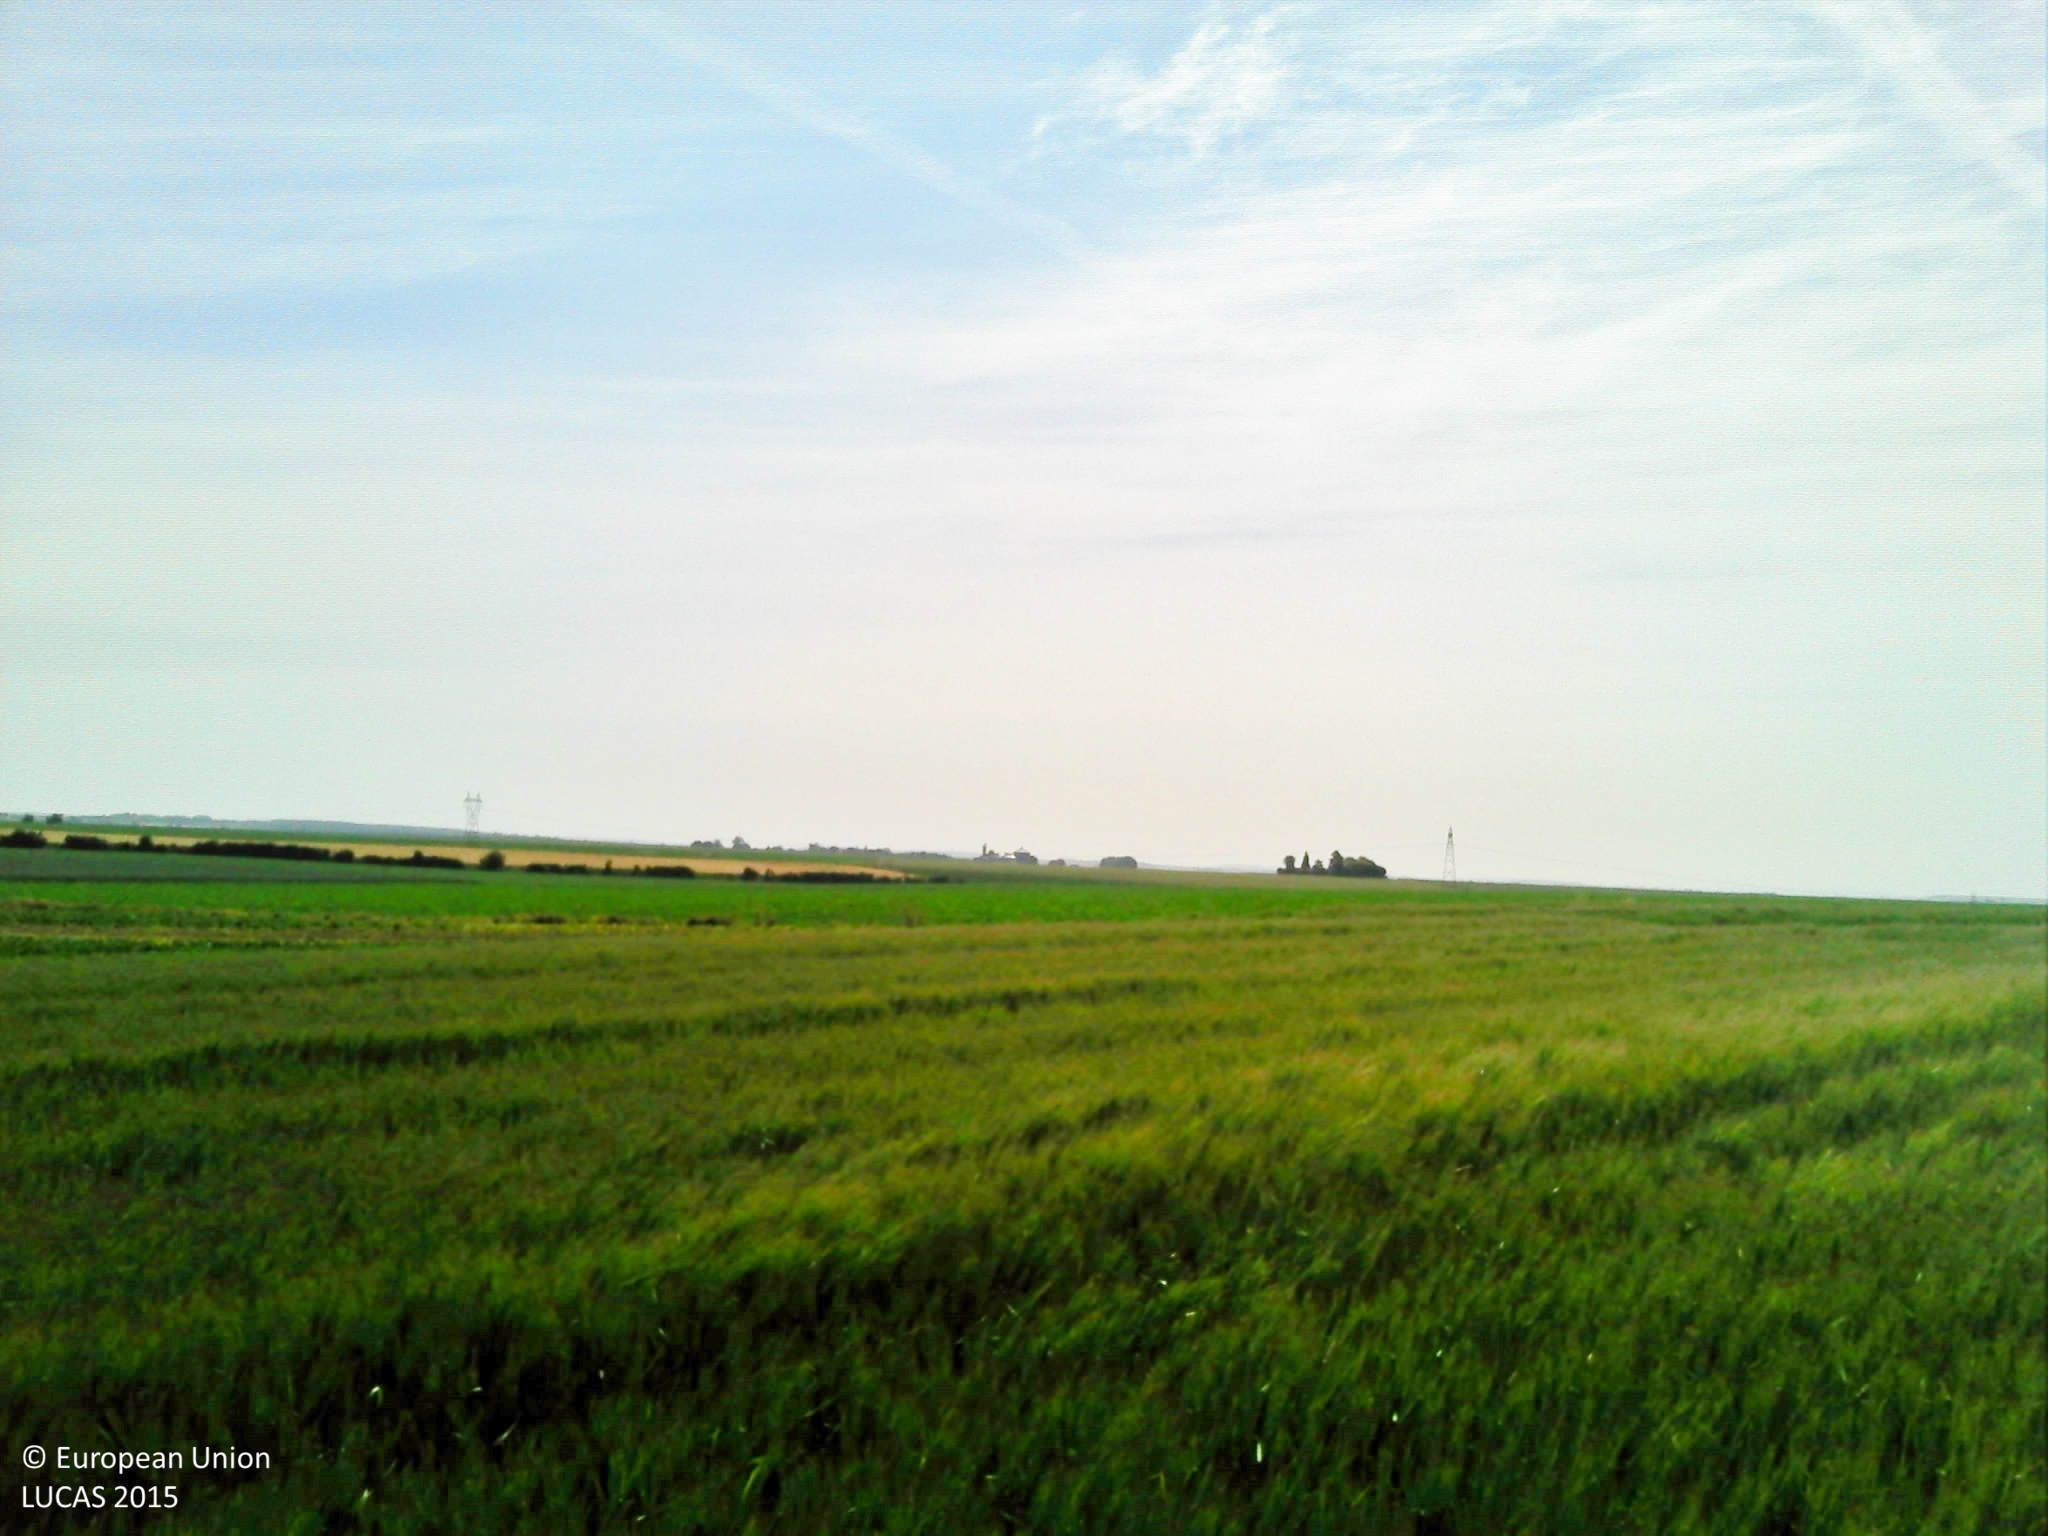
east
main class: Cropland
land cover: Barley
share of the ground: > 75 %
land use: Agriculture (excluding fallow land and kitchen gardens)
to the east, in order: Barley; Grass margins; Sugar beet; Grass margins; Paved roads, cycling and walking lanes; Grass margins; Sugar beet
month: June
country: FR
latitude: 49.5262
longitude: 2.5695
